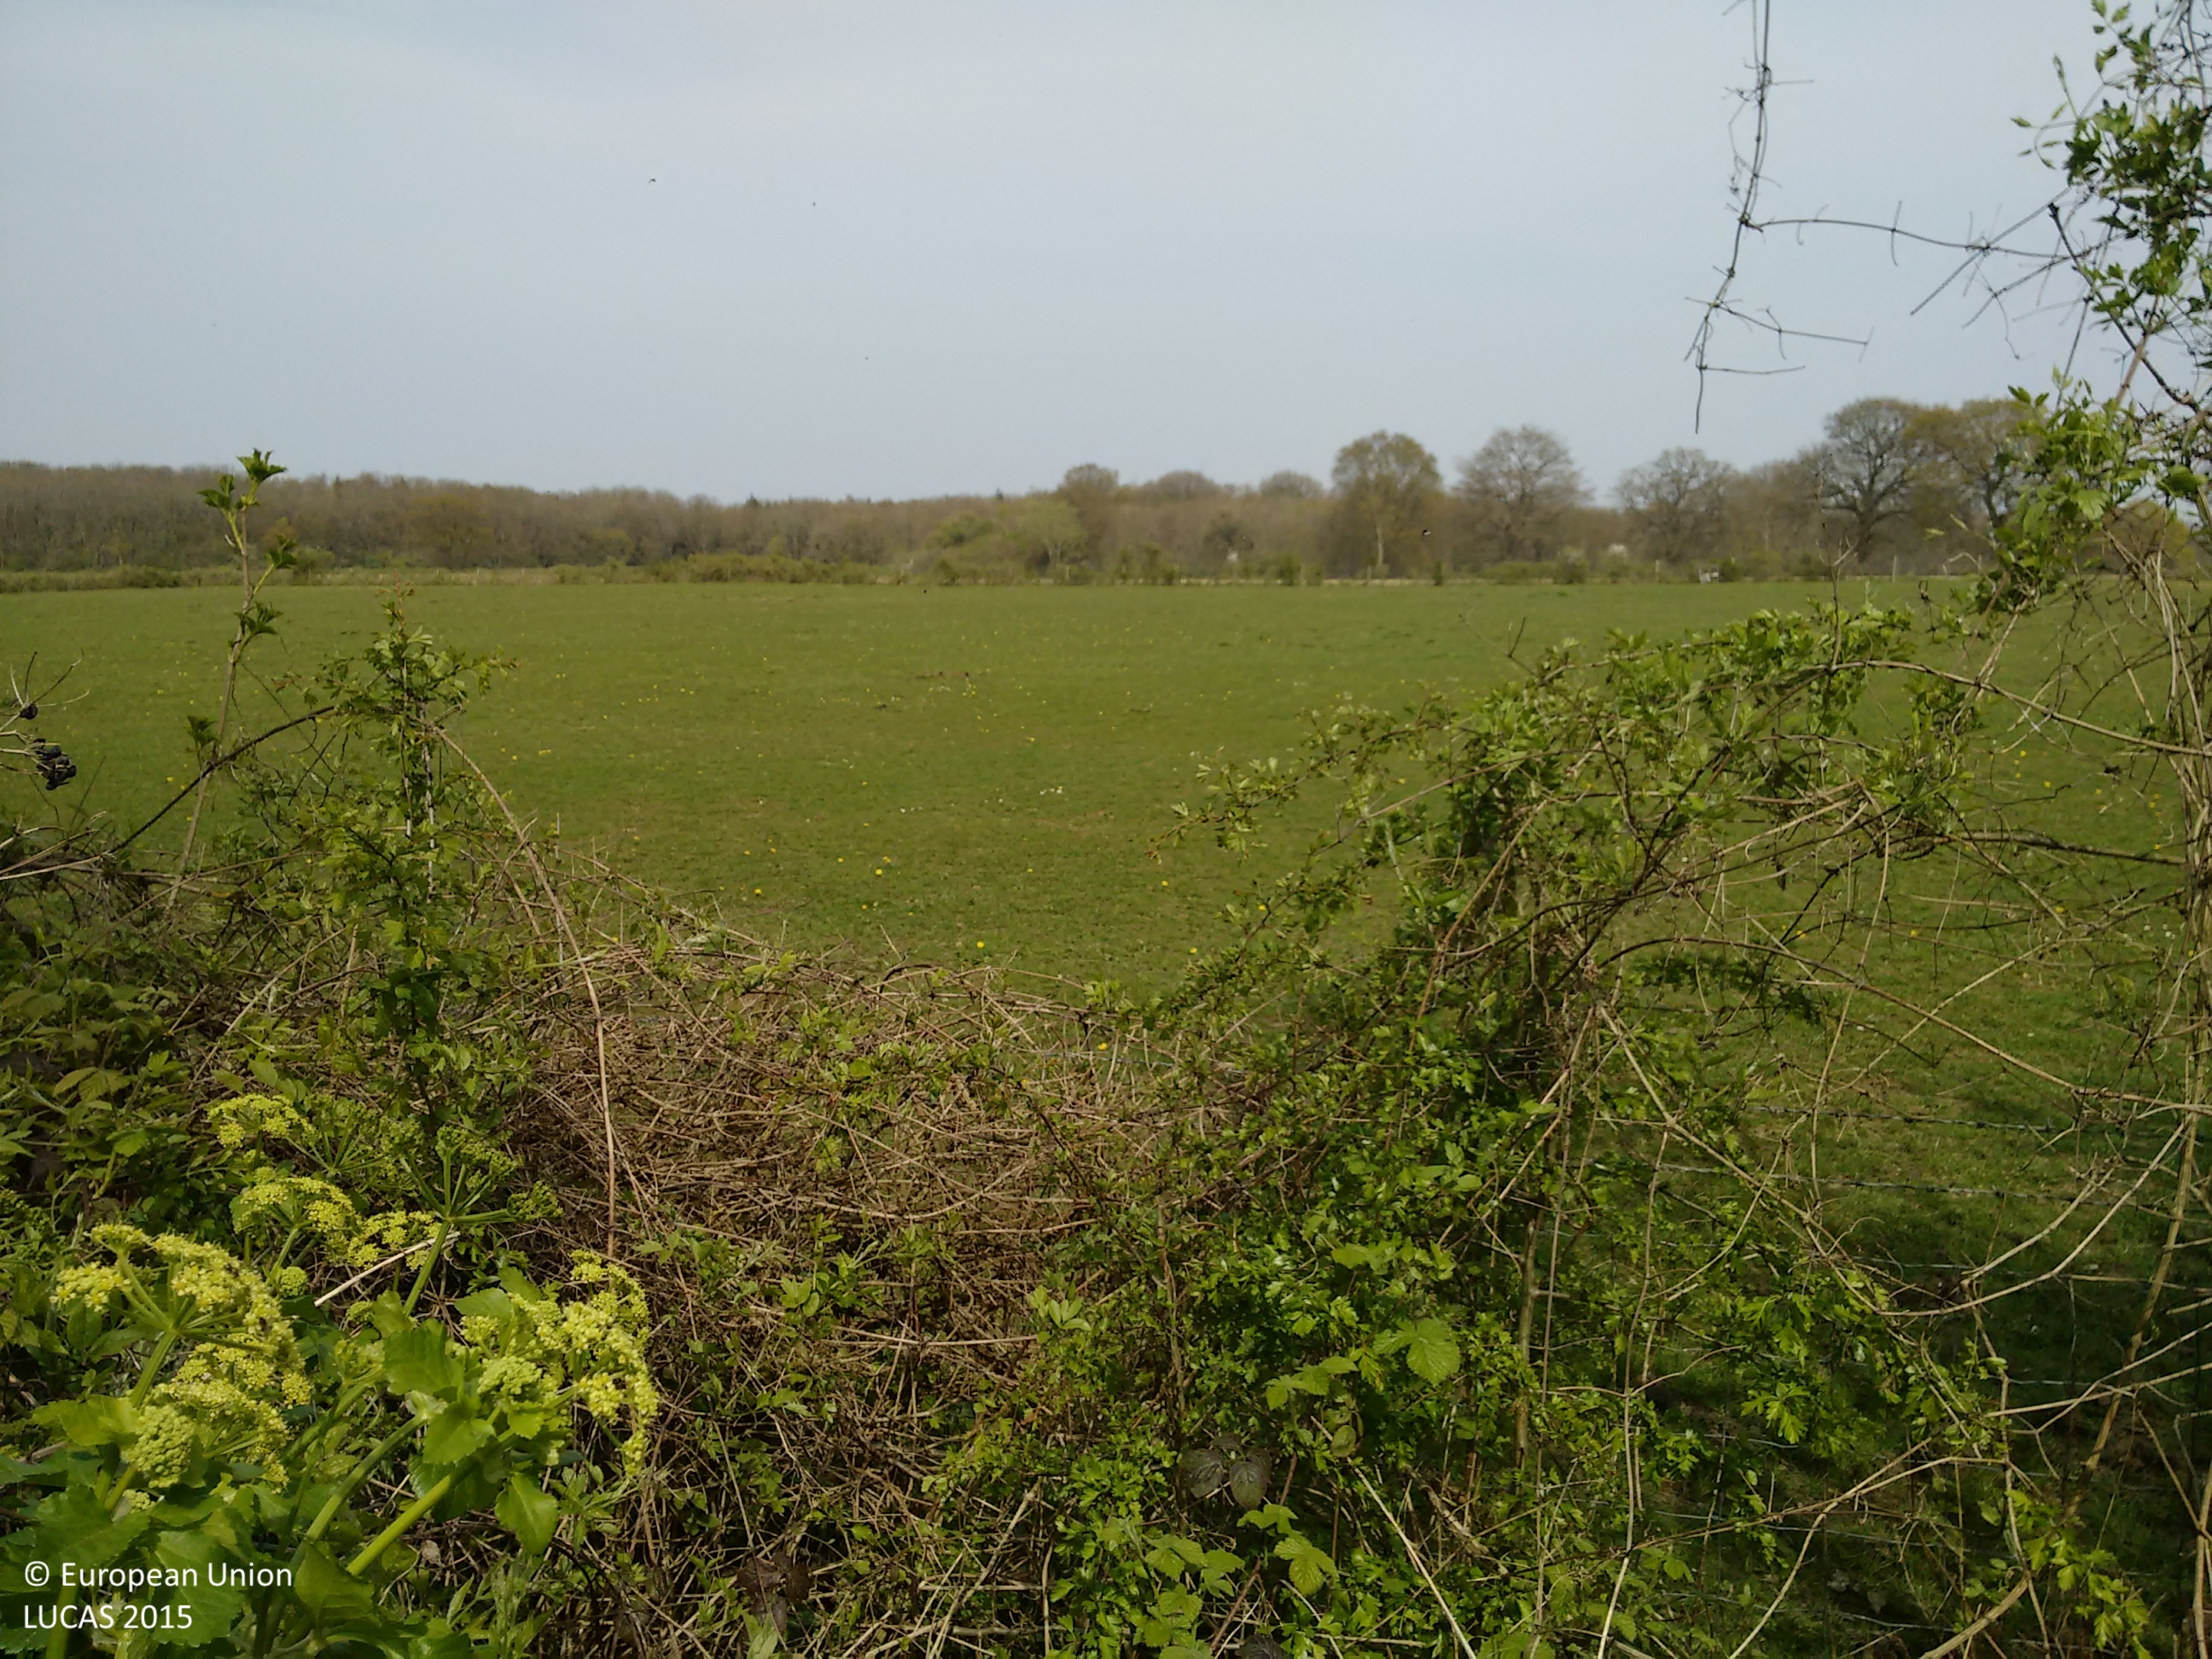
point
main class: Grassland
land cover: Grassland without tree/shrub cover
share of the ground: > 75 %
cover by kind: herbaceous plants 80 %, unconsolidated bare surface 20 %
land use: Agriculture (excluding fallow land and kitchen gardens)
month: April
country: GB
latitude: 51.3425
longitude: 0.4827
